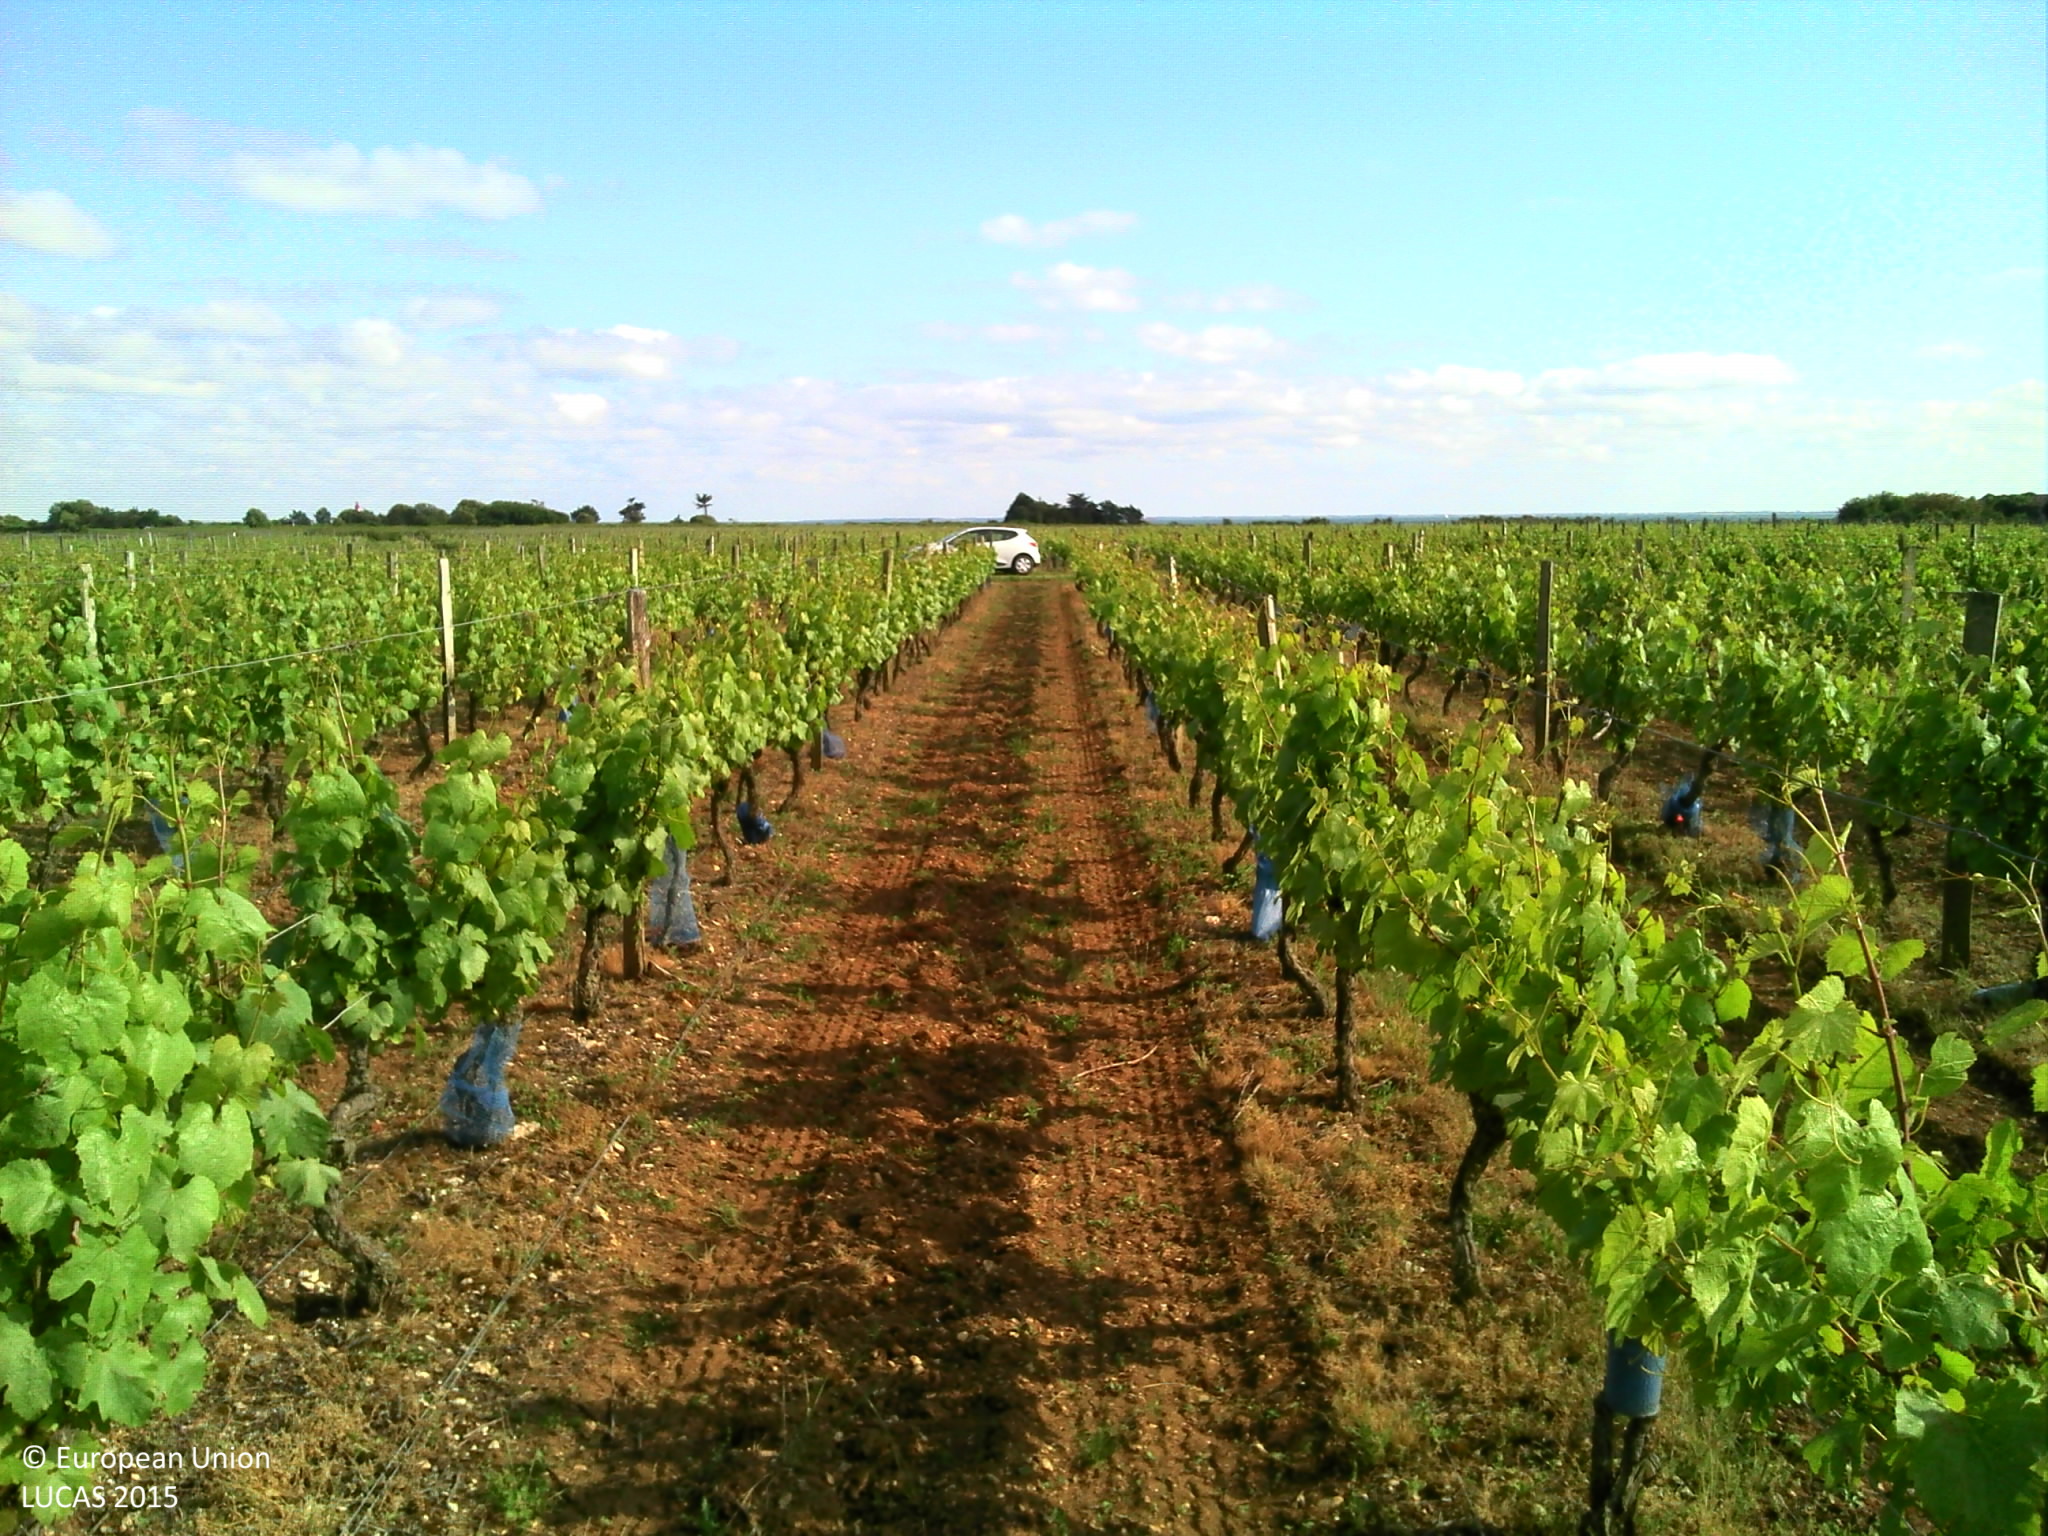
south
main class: Cropland
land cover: Vineyards
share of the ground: 25 - 50 %
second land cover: Other bare soil
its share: > 75 %
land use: Agriculture (excluding fallow land and kitchen gardens)
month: May
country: FR
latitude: 46.1519
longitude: -1.2851
